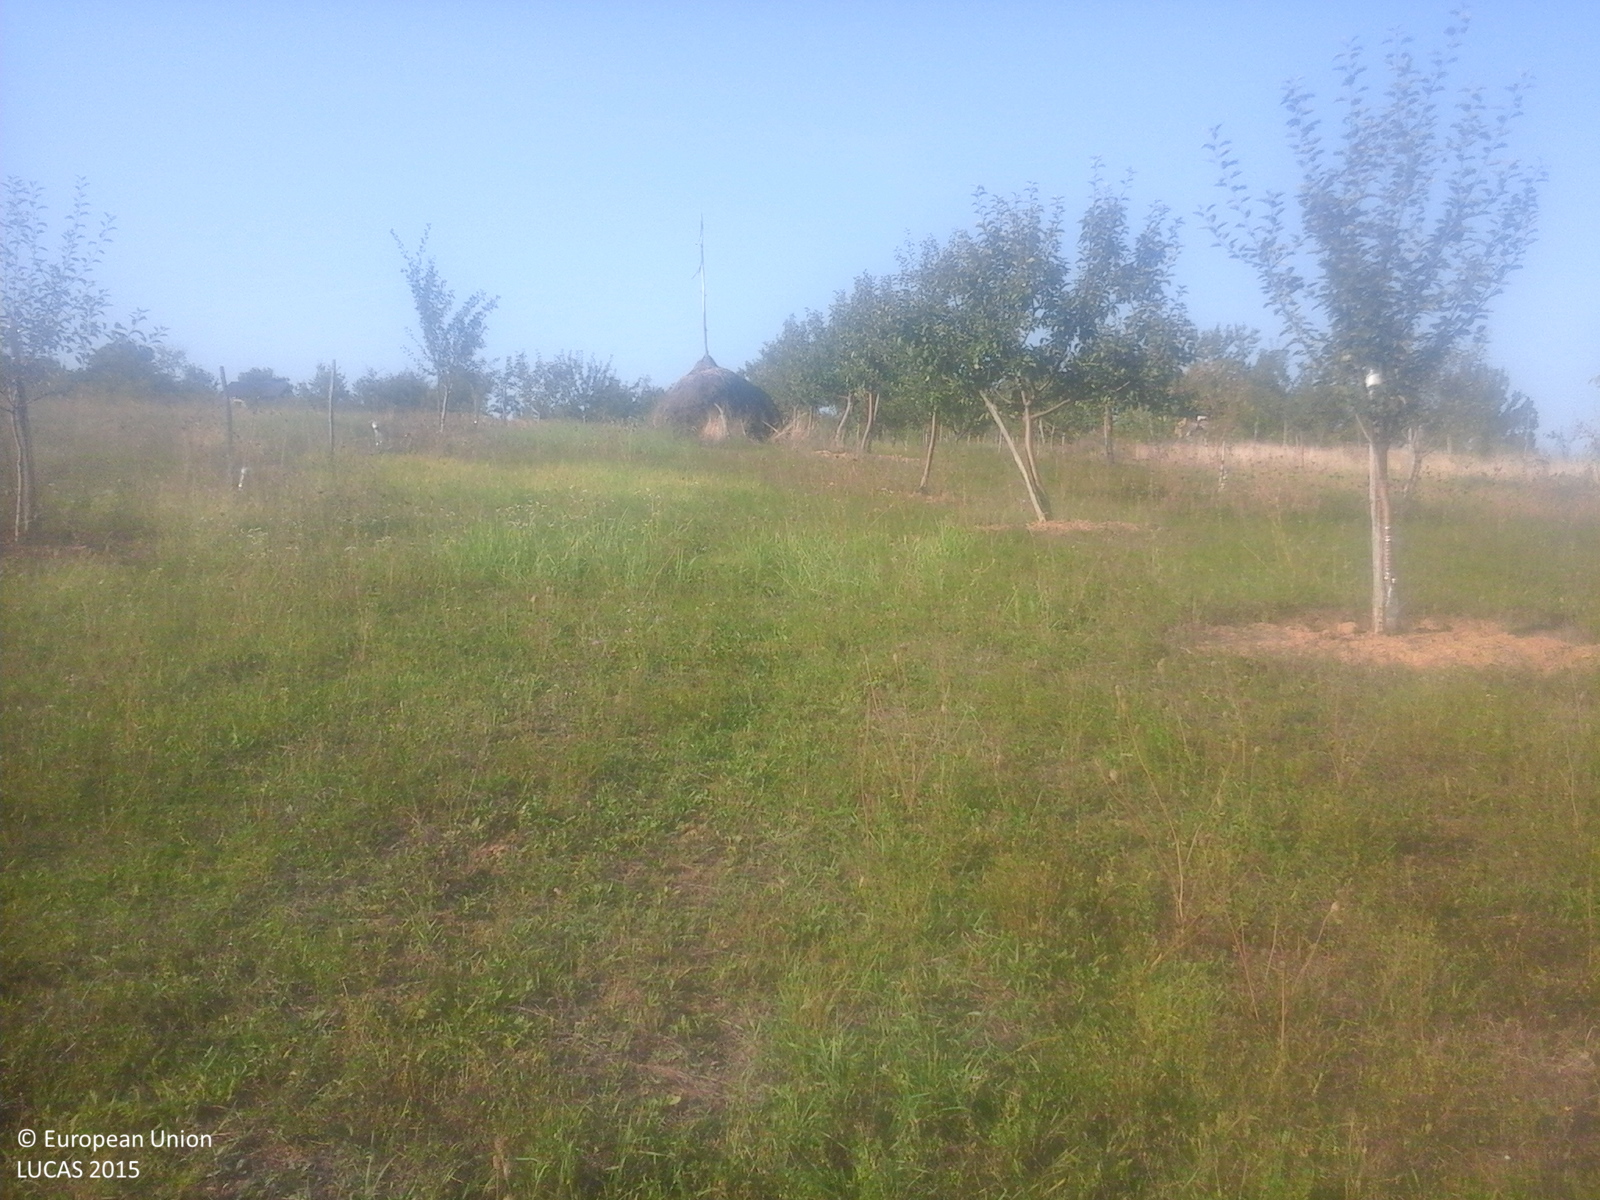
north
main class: Cropland
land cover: Apple fruit
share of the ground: 10 - 25 %
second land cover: Grassland without tree/shrub cover
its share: > 75 %
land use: Agriculture (excluding fallow land and kitchen gardens)
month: September
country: RO
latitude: 46.6172
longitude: 22.3376
